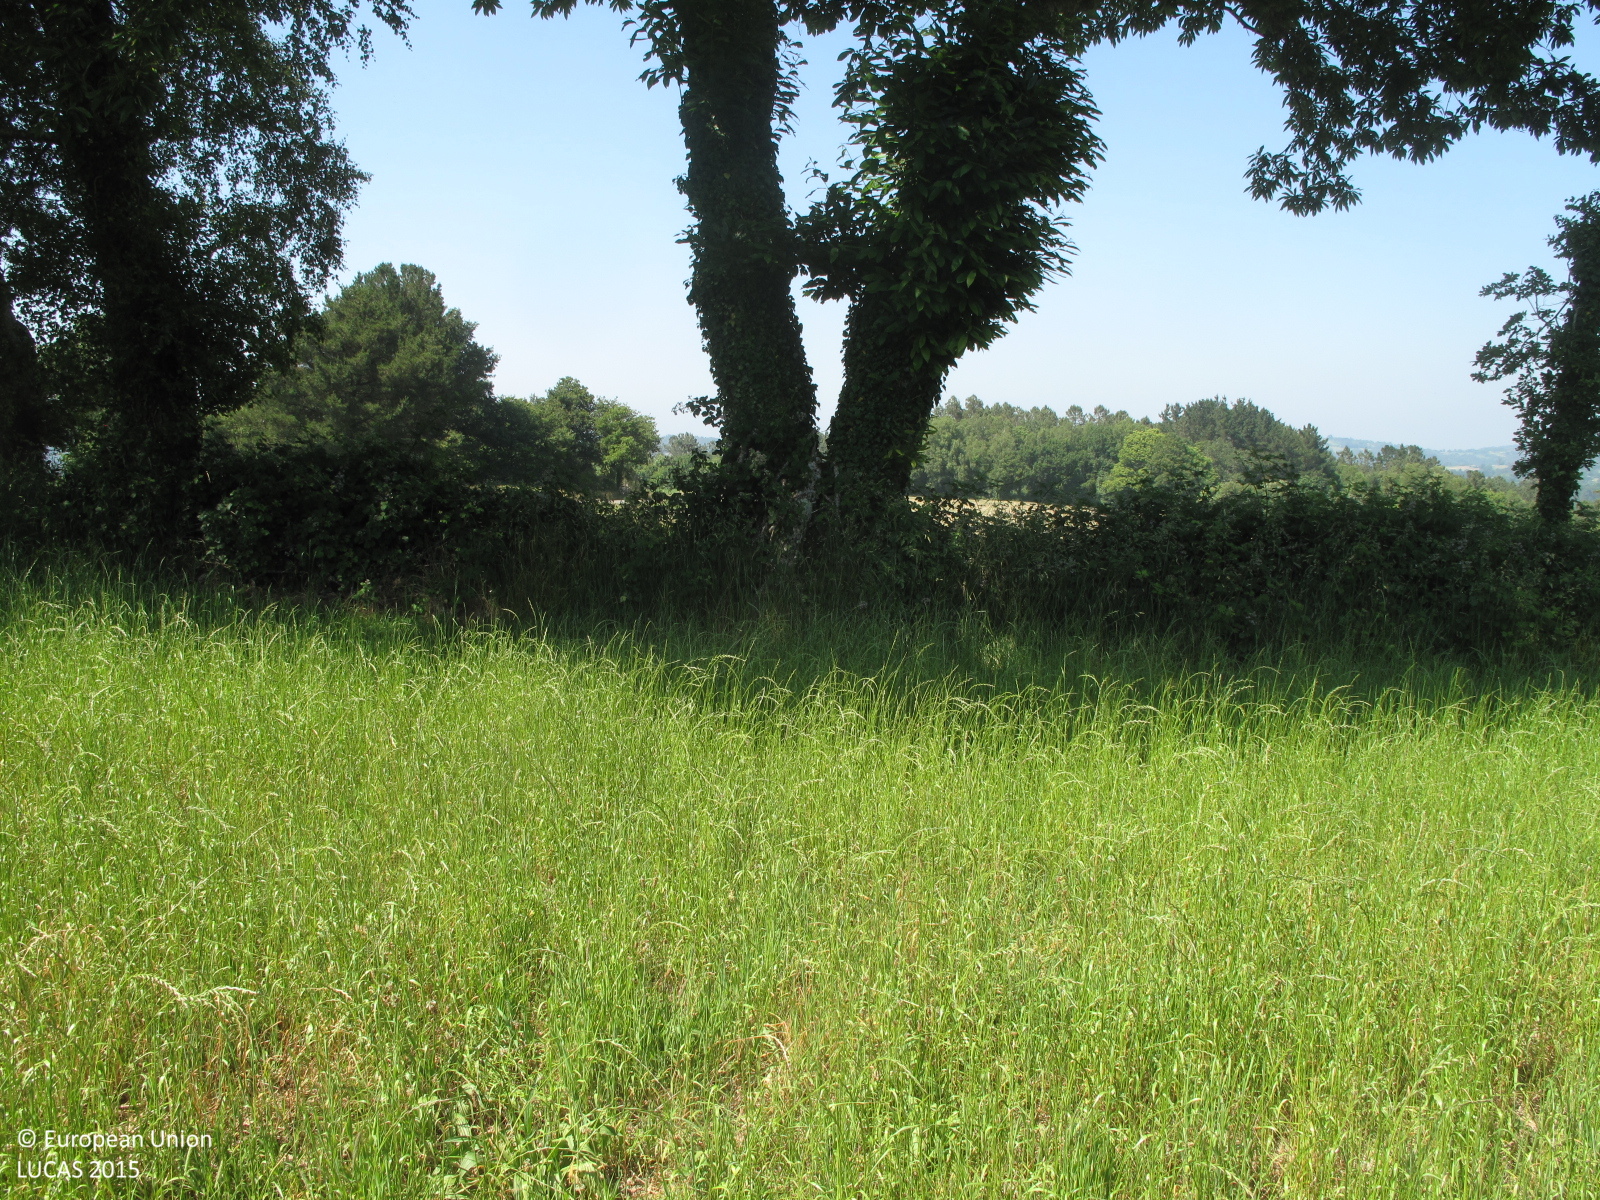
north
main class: Grassland
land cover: Grassland without tree/shrub cover
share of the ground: > 75 %
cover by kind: herbaceous plants 100 %
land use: Agriculture (excluding fallow land and kitchen gardens)
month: June
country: ES
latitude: 43.3035
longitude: -7.9550
